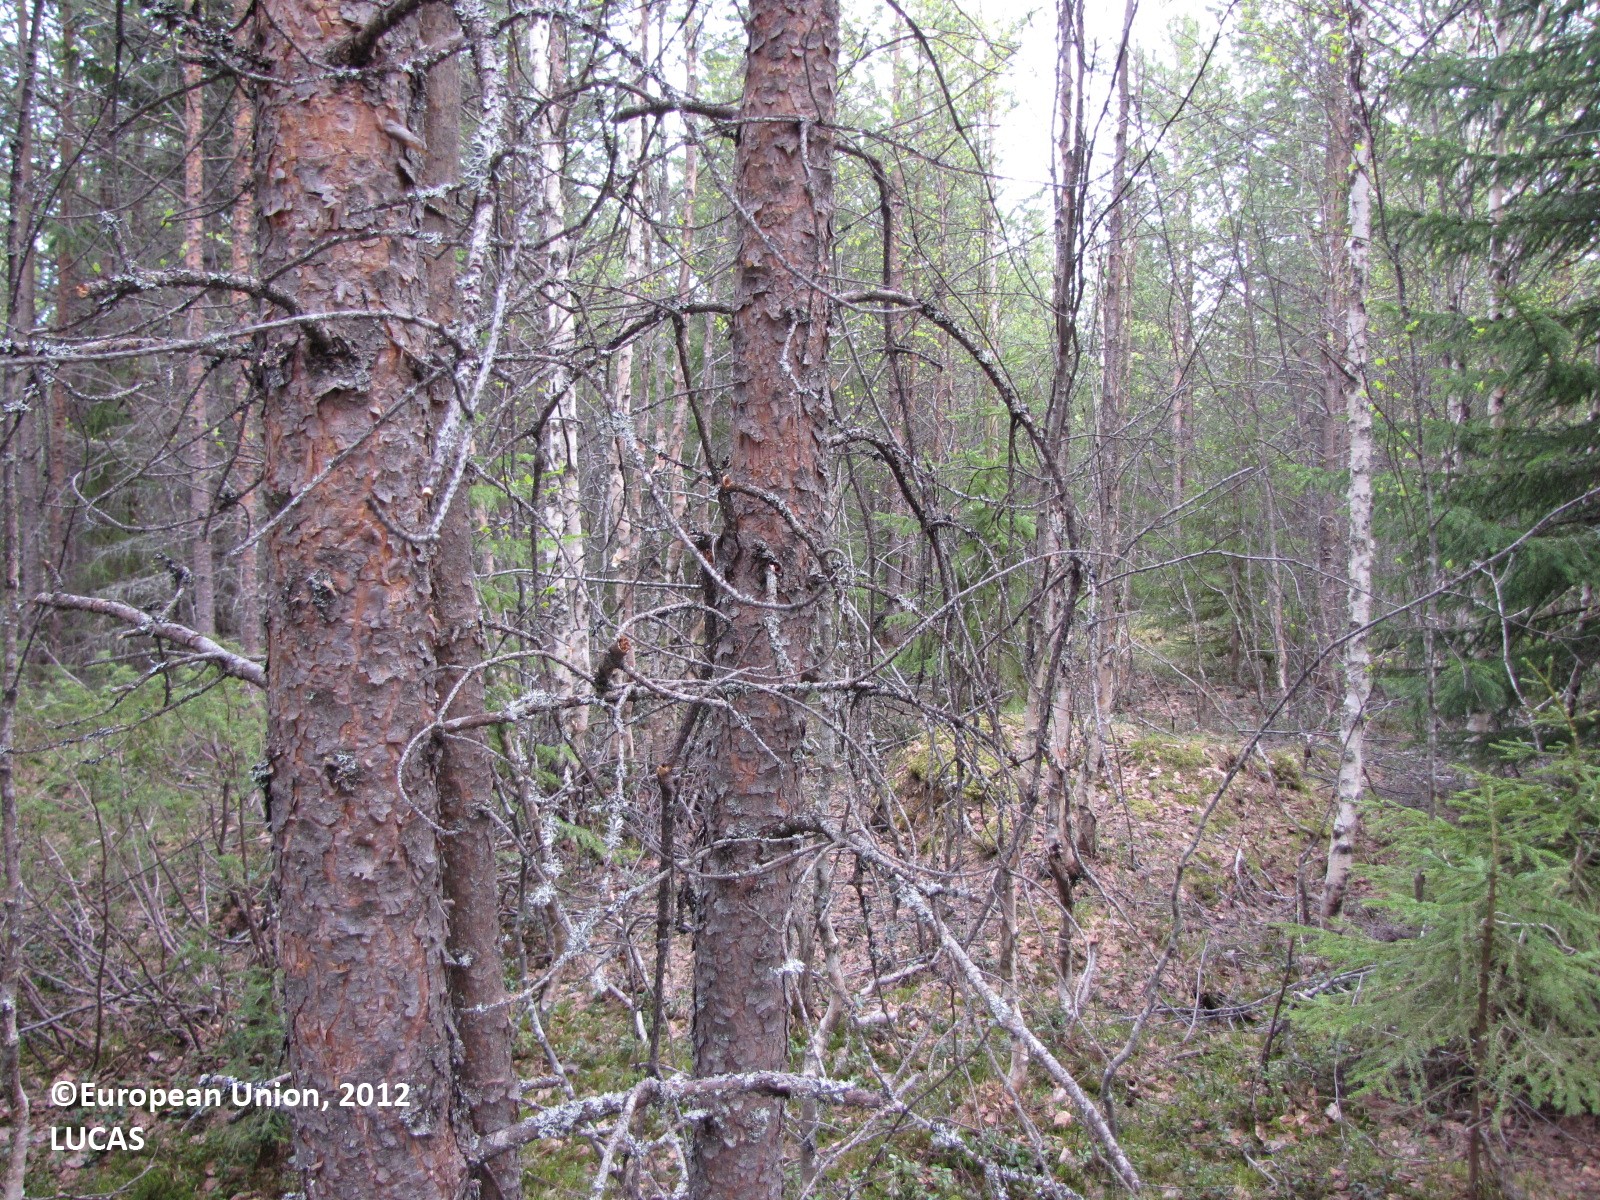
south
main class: Woodland
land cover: Other mixed woodland
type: boreal forest
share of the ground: > 75 %
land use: Forestry
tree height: > 5 m
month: May
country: FI
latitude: 65.7218
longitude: 24.6833
